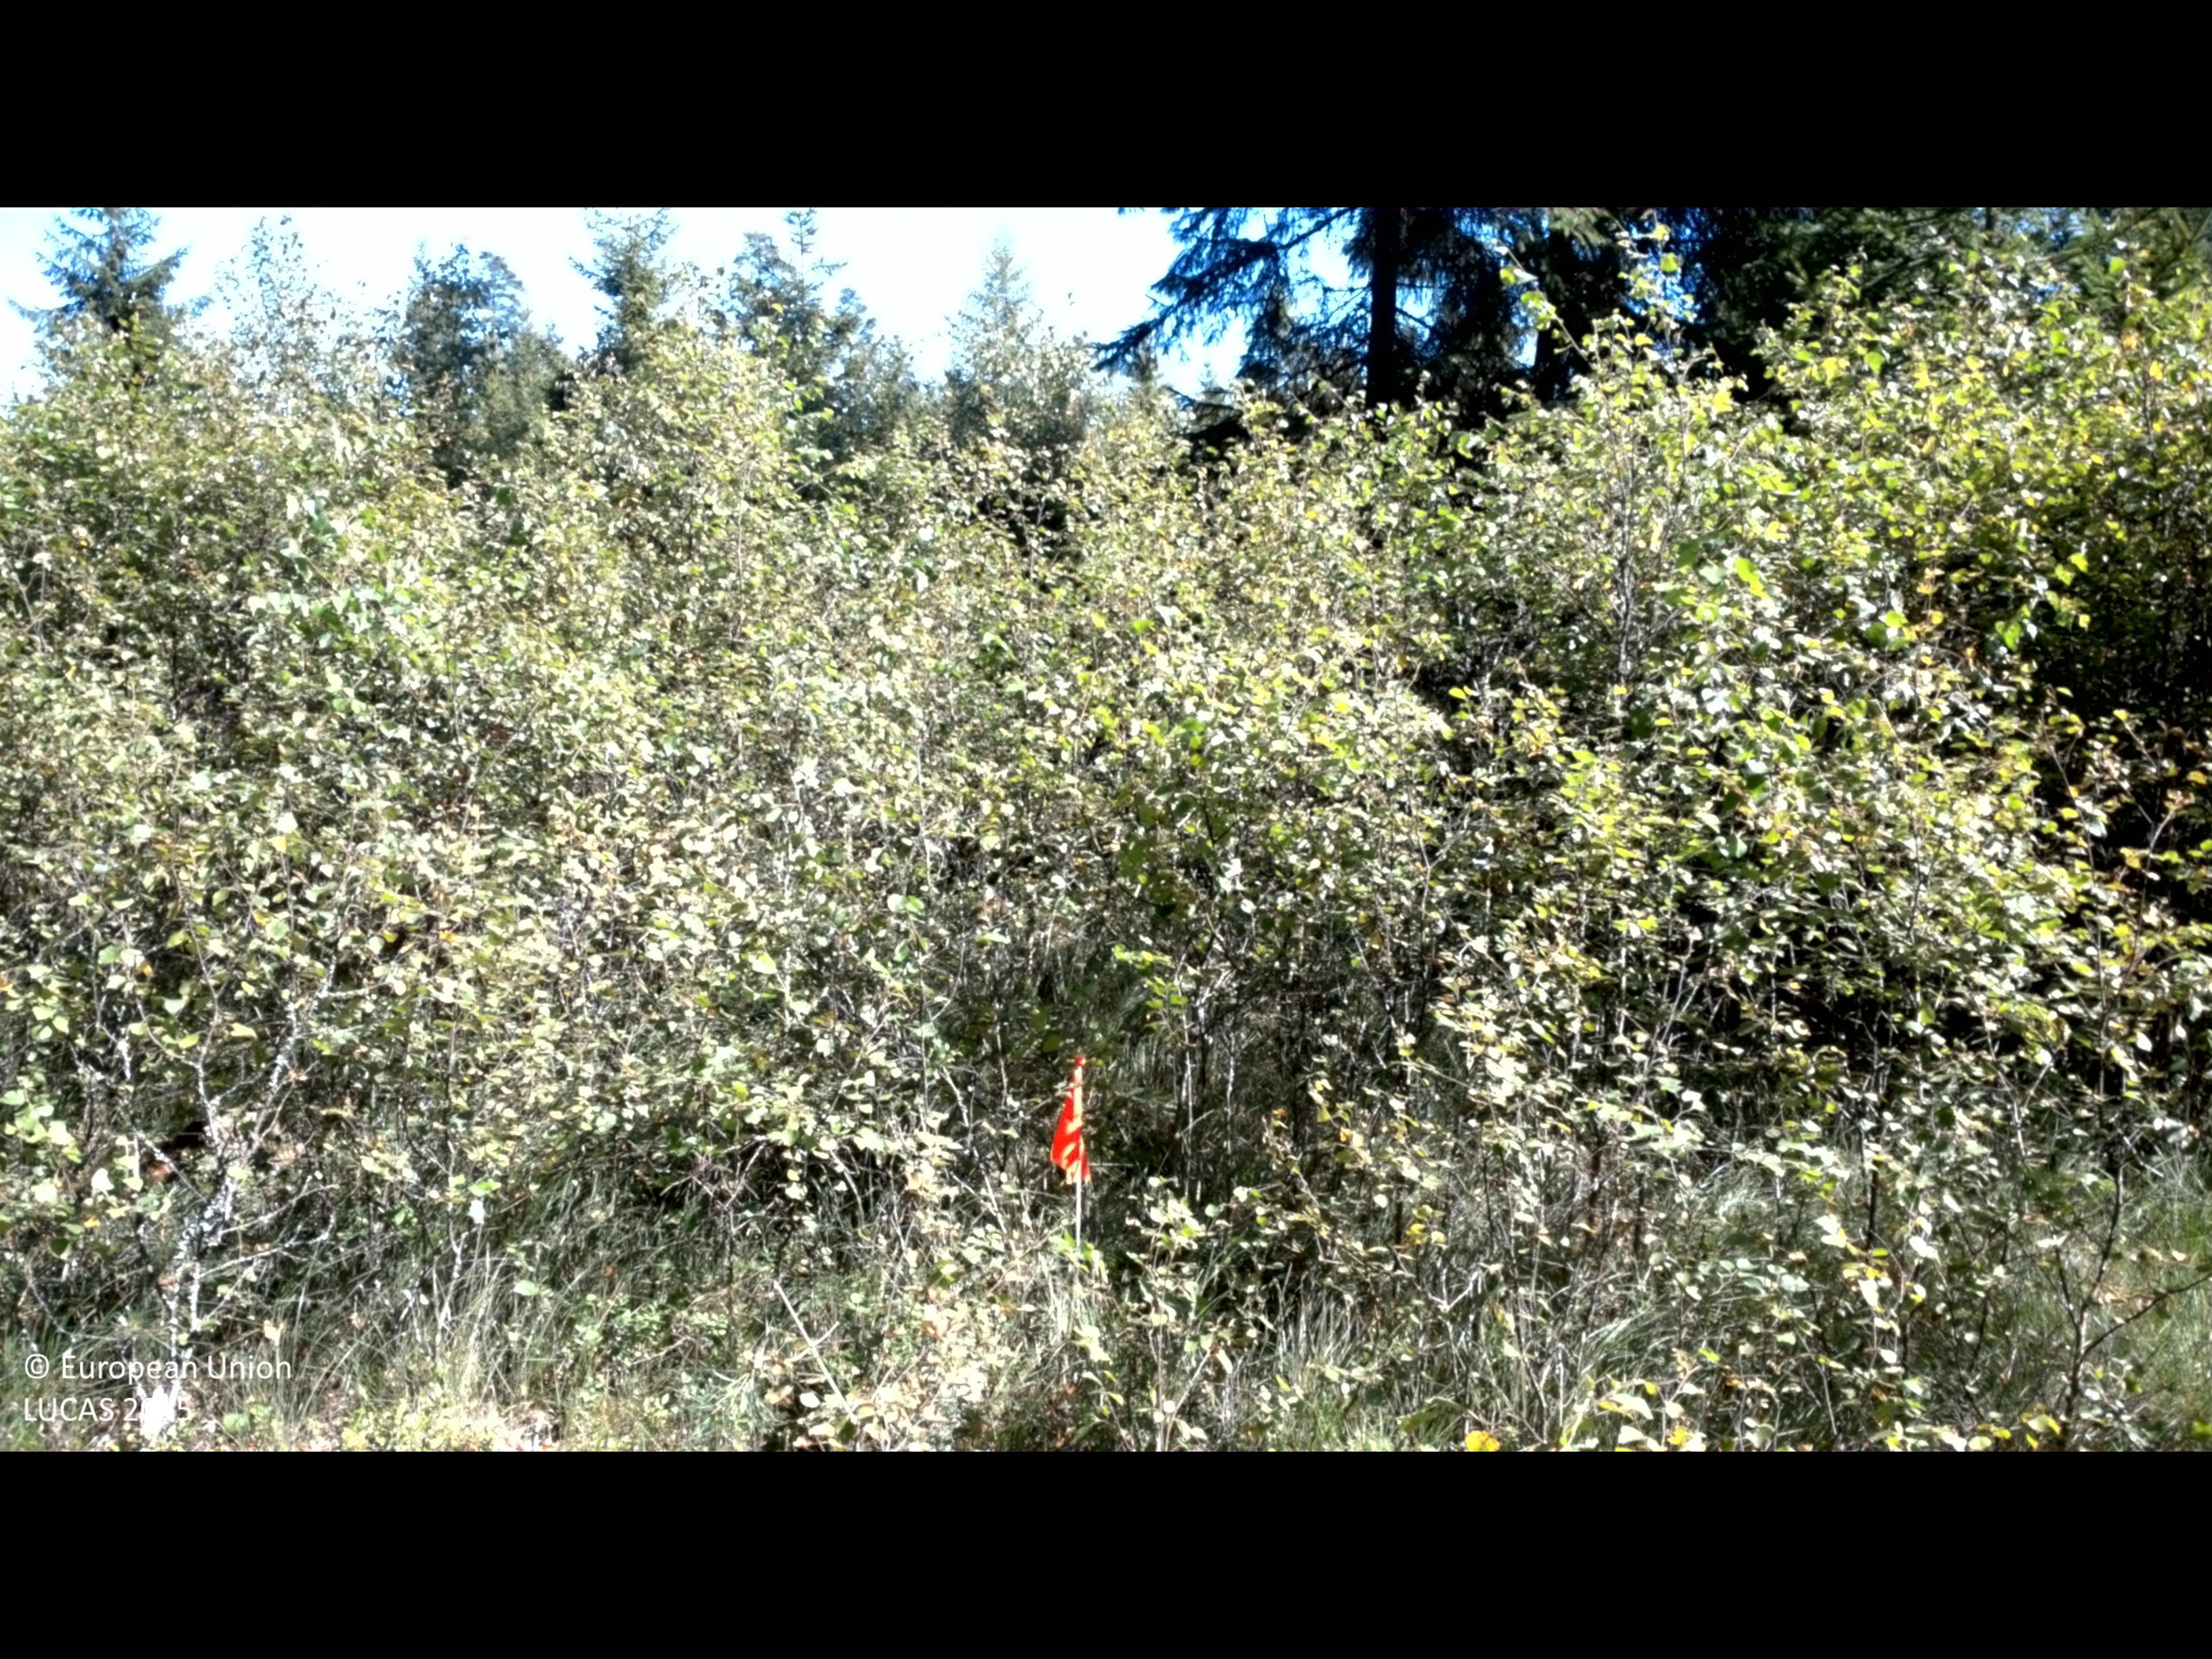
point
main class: Woodland
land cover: Spruce dominated mixed woodland
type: boreal forest
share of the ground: > 75 %
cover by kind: broadleaved forest trees 55 %, coniferous forest trees 30 %, shrubs 10 %, herbaceous plants 5 %
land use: Forestry
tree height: > 5 m
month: August
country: SE
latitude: 56.7281
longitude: 14.2953
